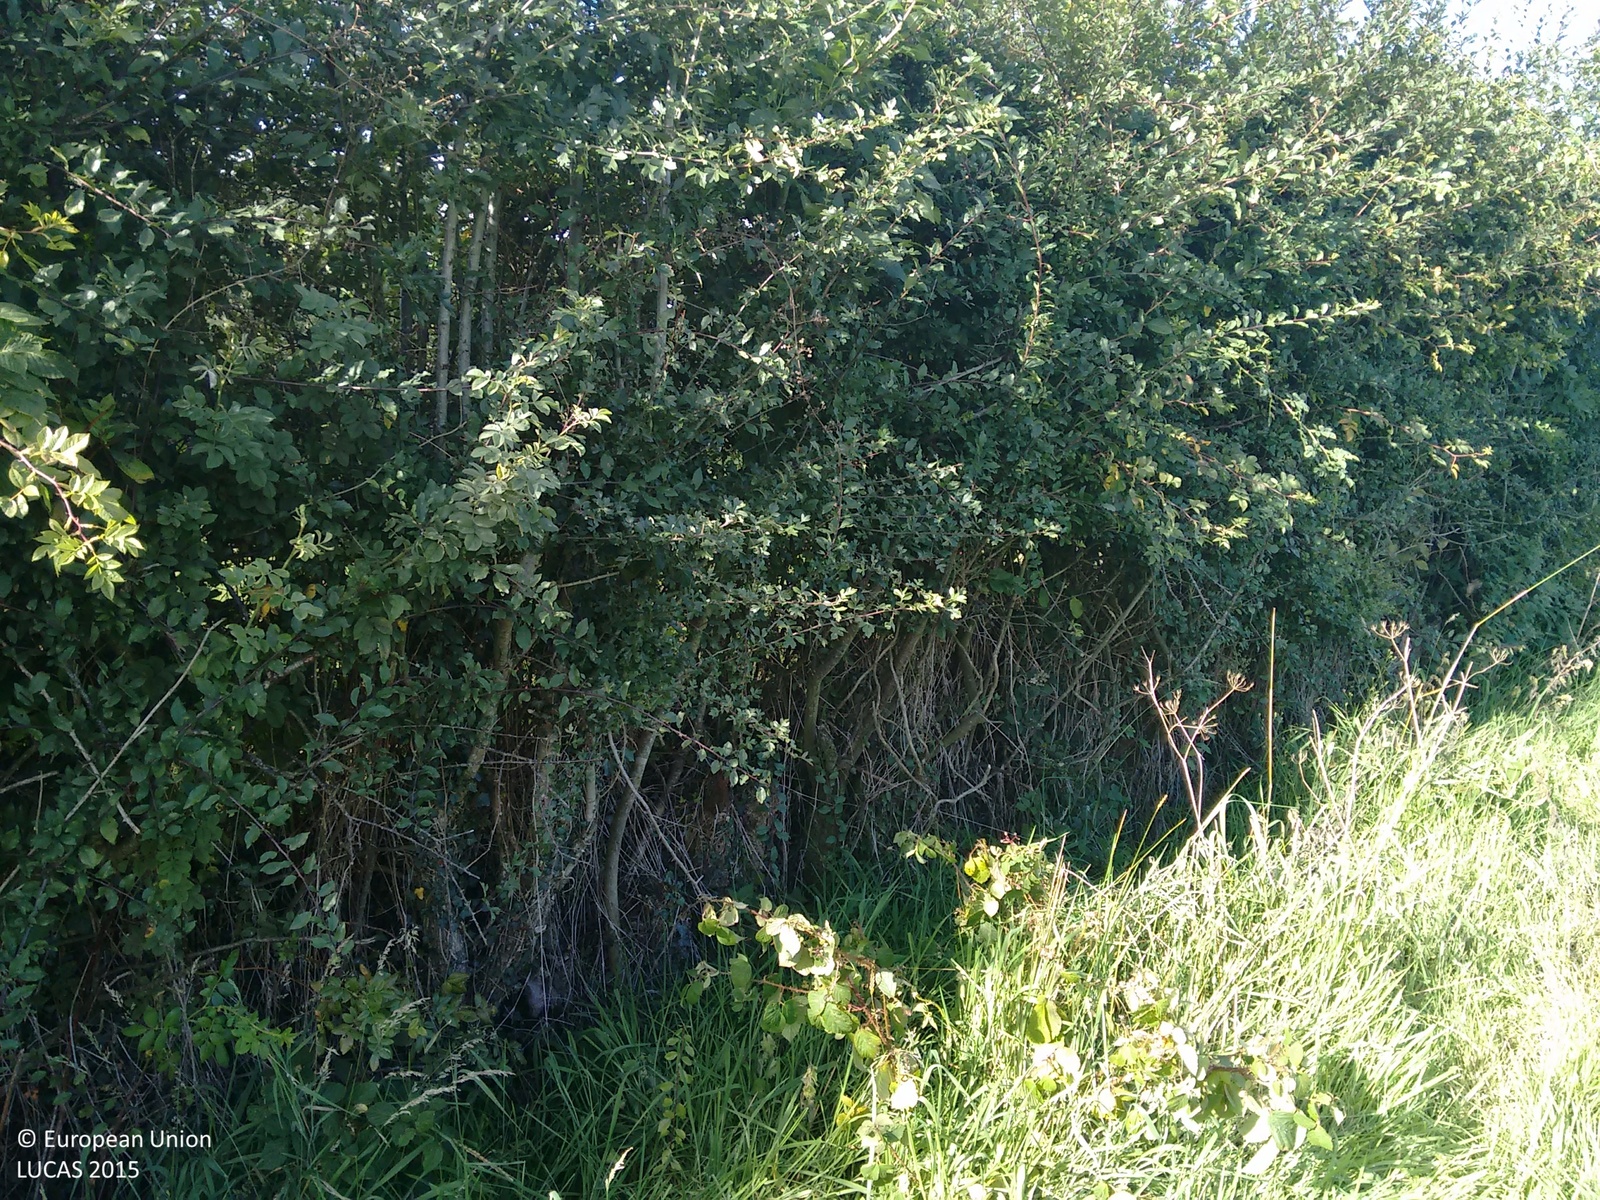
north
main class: Grassland
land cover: Grassland without tree/shrub cover
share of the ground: > 75 %
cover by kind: herbaceous plants 100 %
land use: Agriculture (excluding fallow land and kitchen gardens)
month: September
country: IE
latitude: 54.2119
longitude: -6.8652
